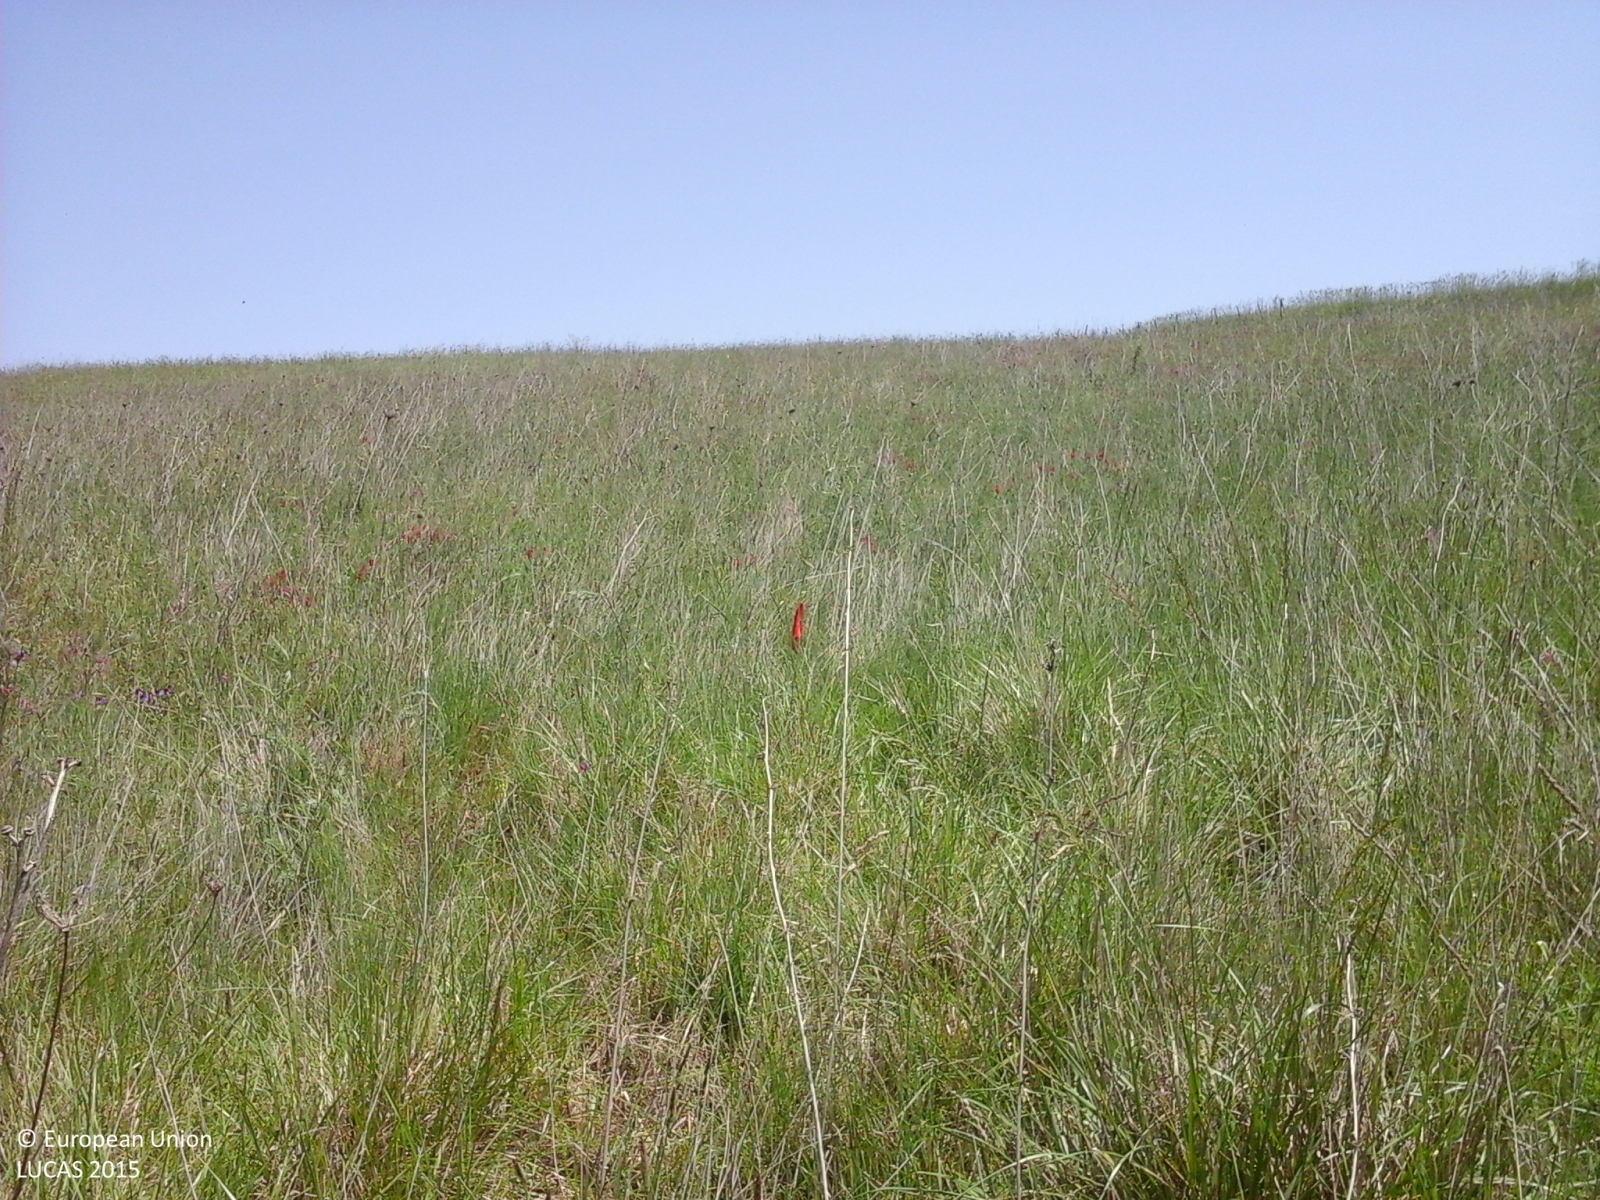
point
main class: Grassland
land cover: Spontaneously vegetated surfaces
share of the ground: > 75 %
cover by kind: herbaceous plants 100 %
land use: Fallow land
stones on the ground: < 10 %
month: May
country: IT
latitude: 37.7704
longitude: 14.0465
